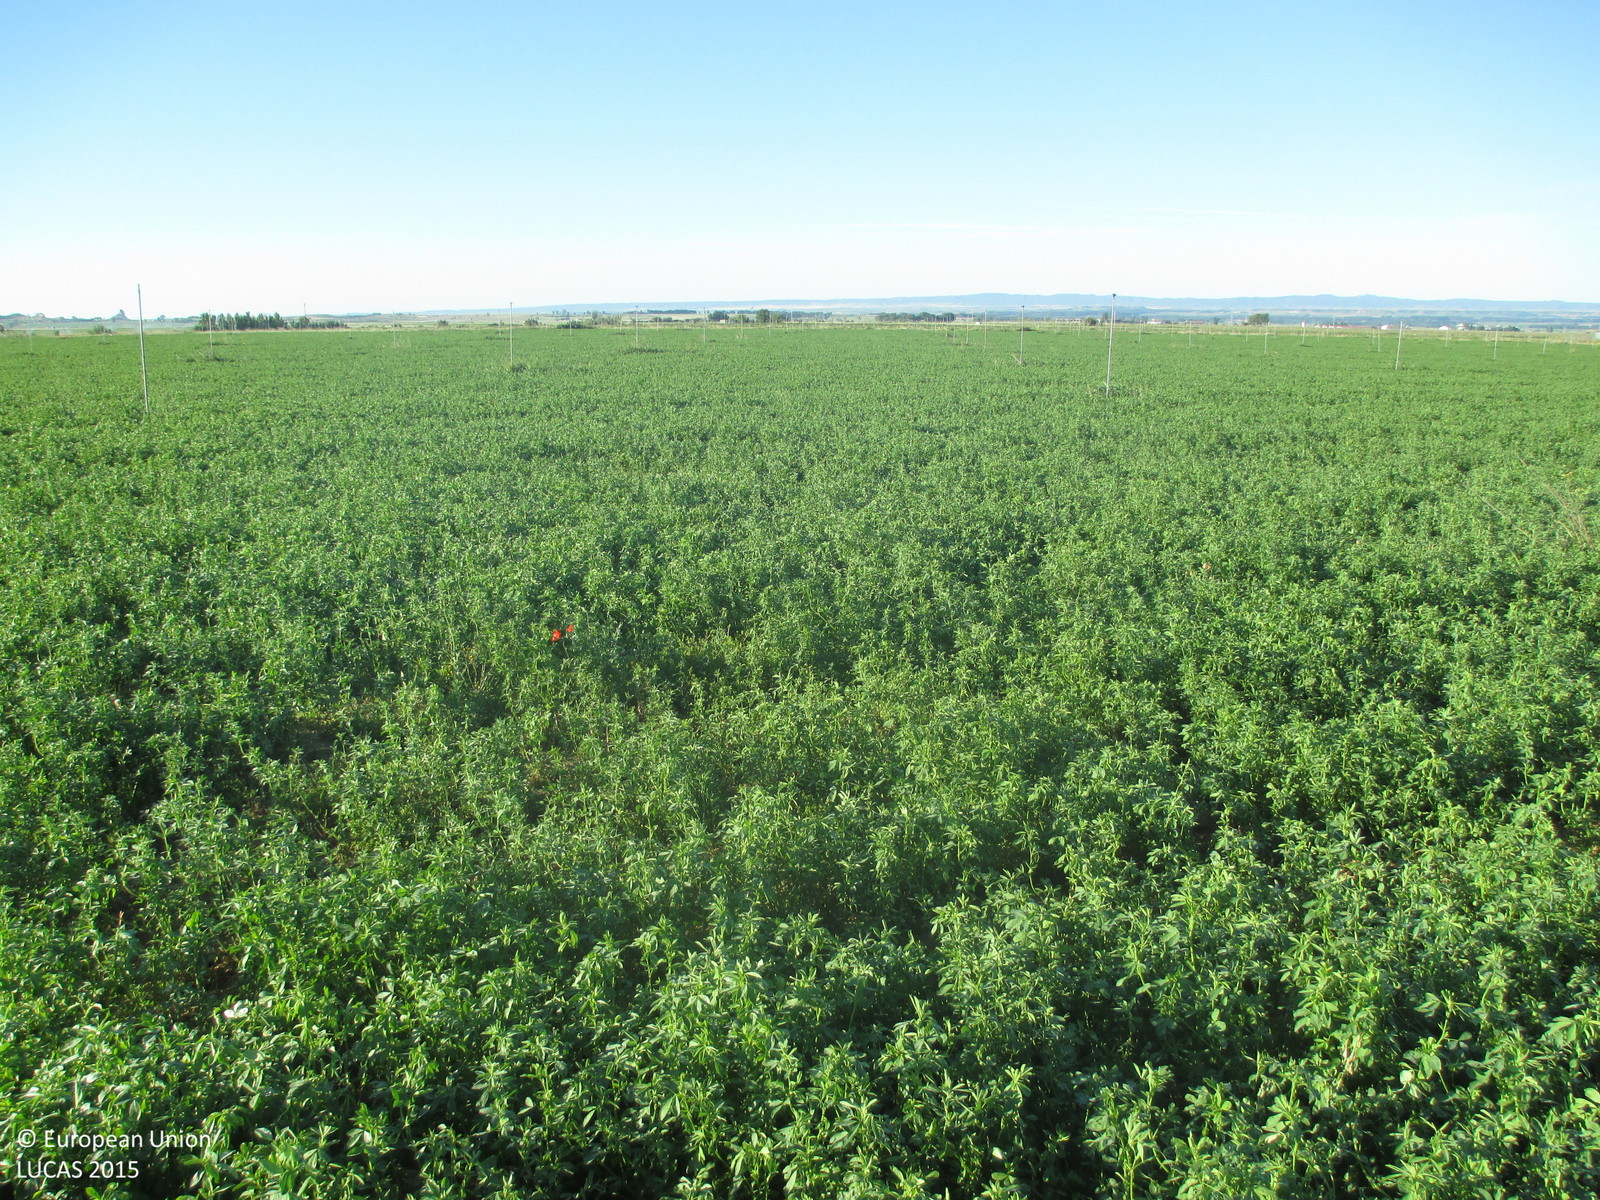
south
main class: Cropland
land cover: Lucerne
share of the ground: > 75 %
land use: Agriculture (excluding fallow land and kitchen gardens)
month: May
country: ES
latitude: 41.9804
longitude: -0.3155
